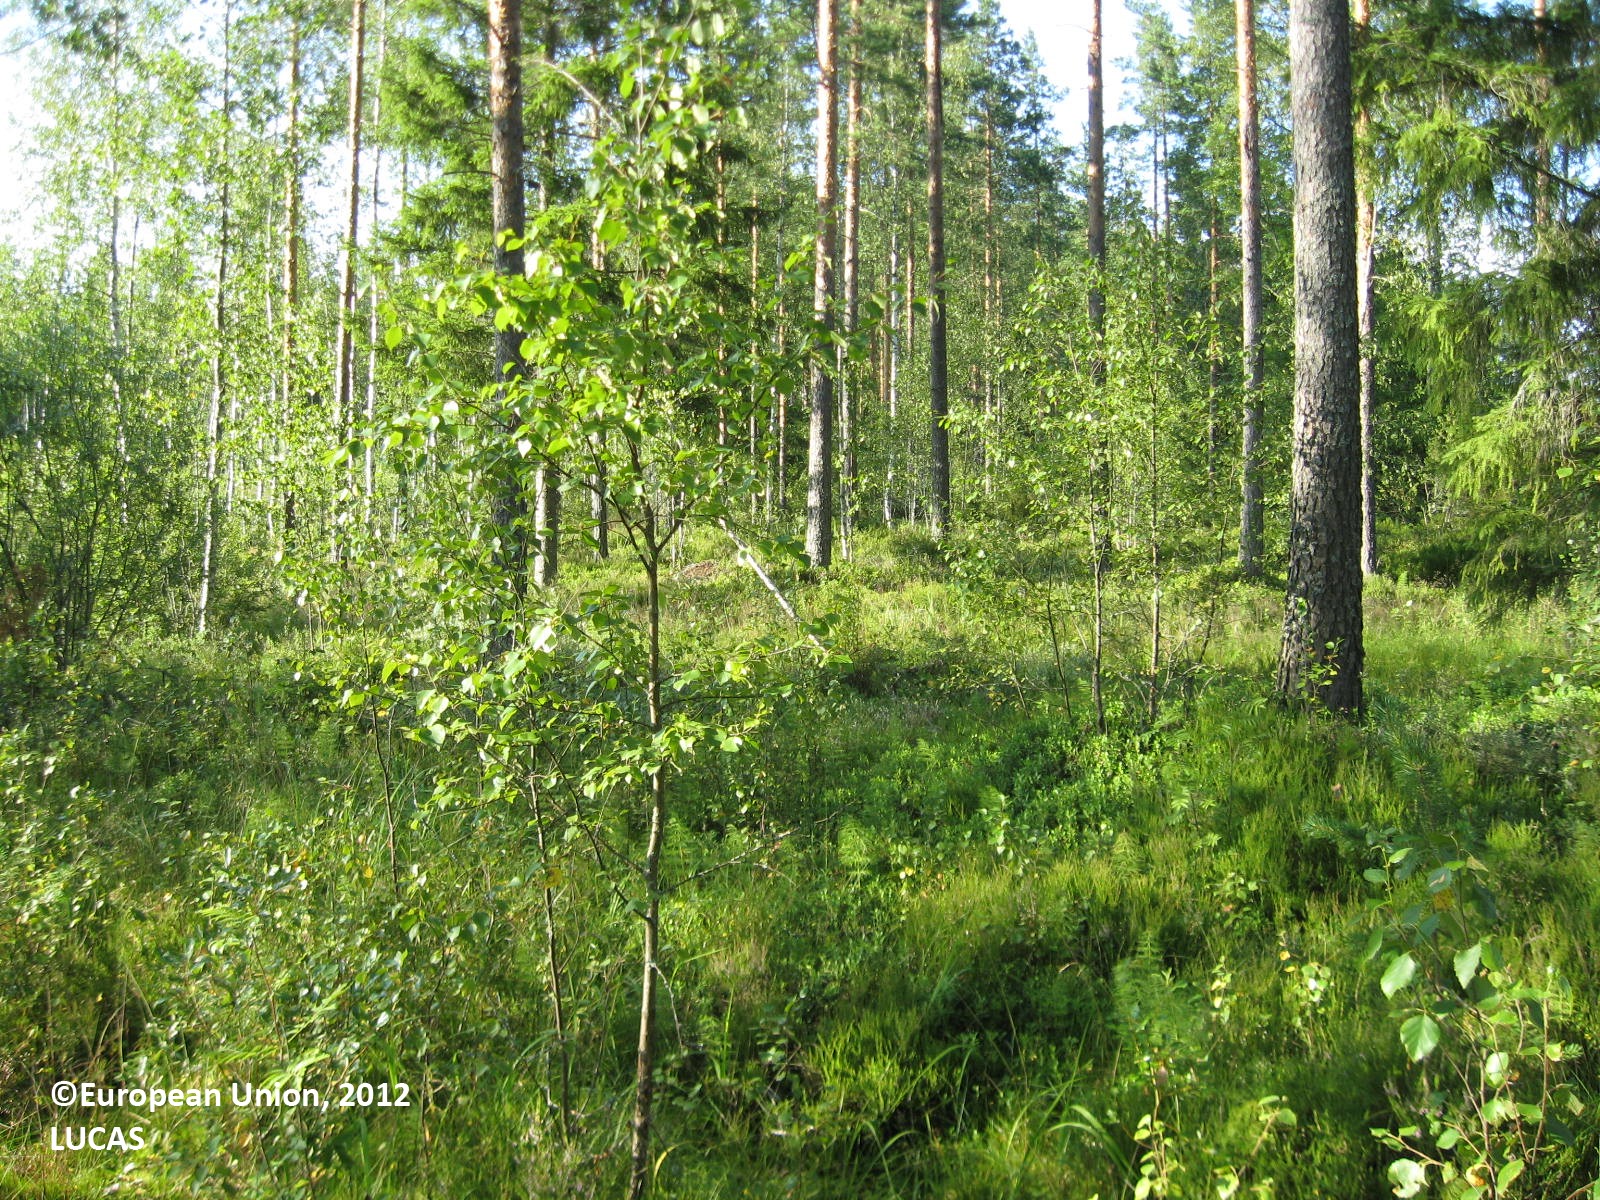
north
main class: Woodland
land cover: Pine dominated mixed woodland
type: boreal forest
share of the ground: > 75 %
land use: Forestry
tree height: > 5 m
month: July
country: FI
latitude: 61.9150
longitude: 22.6098
